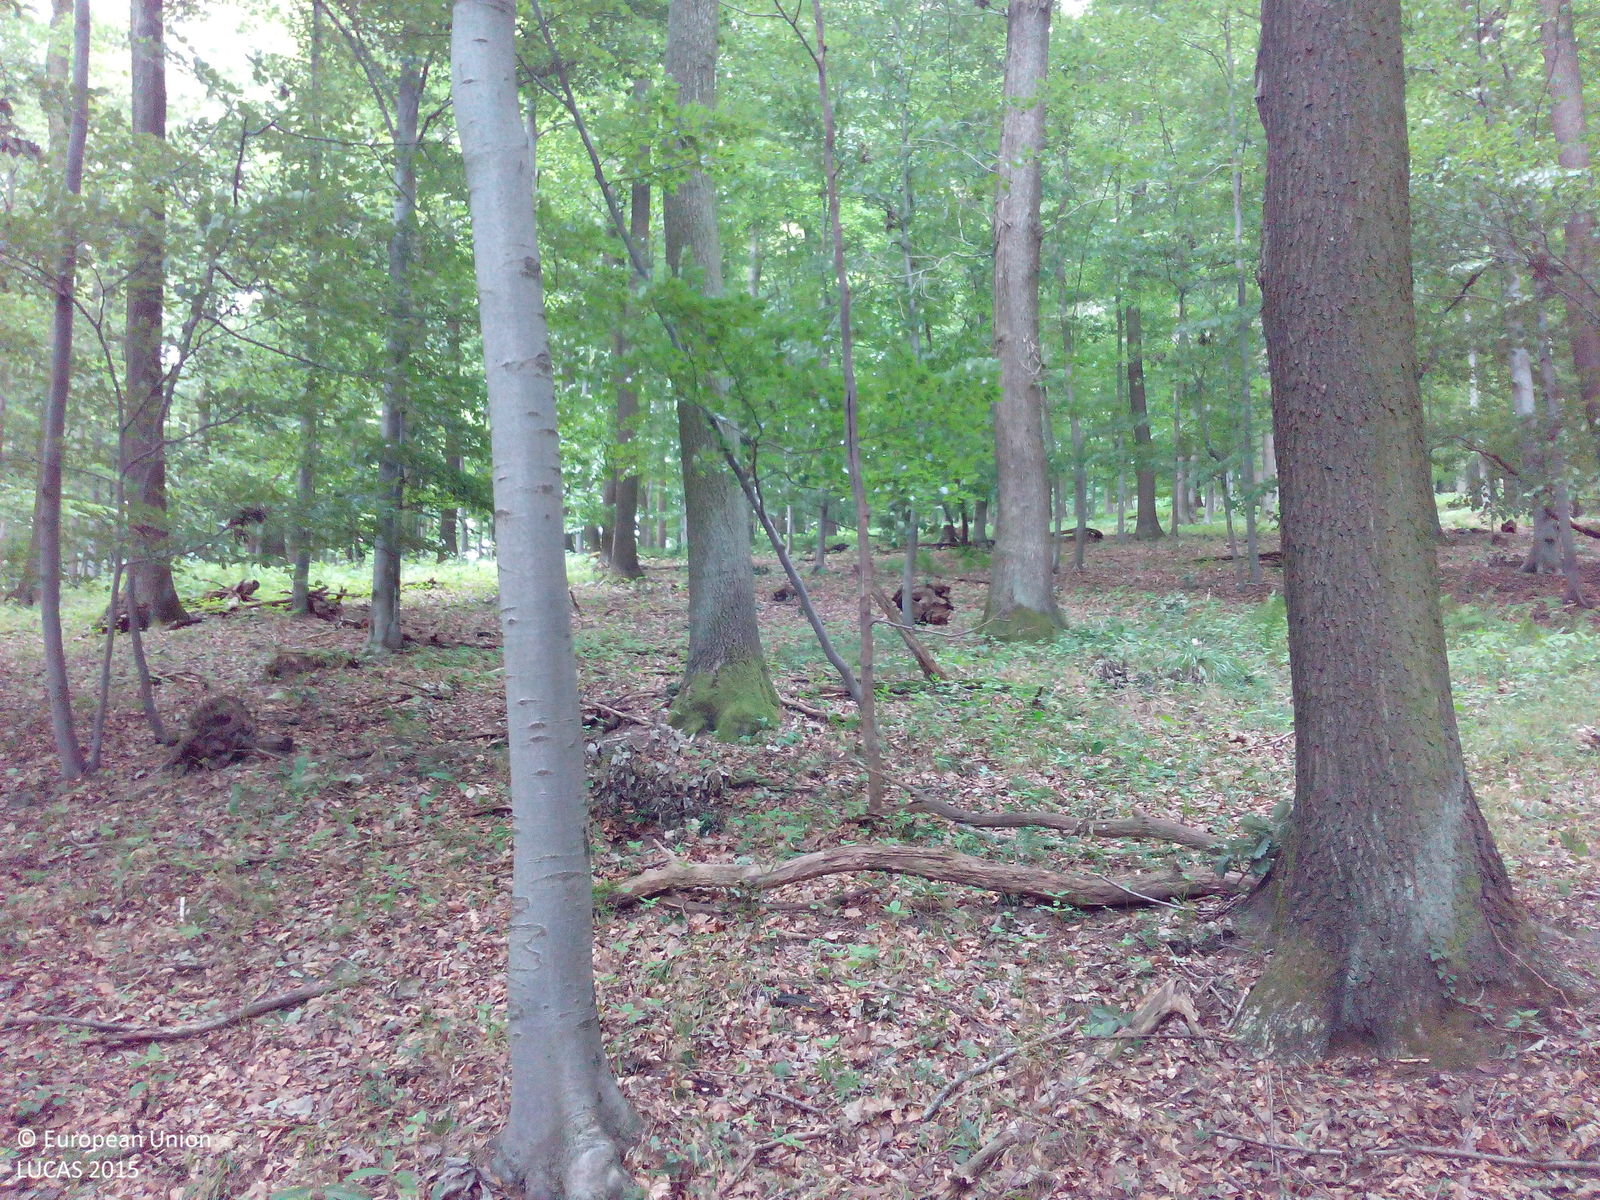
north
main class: Woodland
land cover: Broadleaved woodland
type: beech forest
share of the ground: > 75 %
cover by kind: broadleaved forest trees 100 %
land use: Forestry
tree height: > 5 m
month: July
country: DE
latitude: 51.7843
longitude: 9.9565
